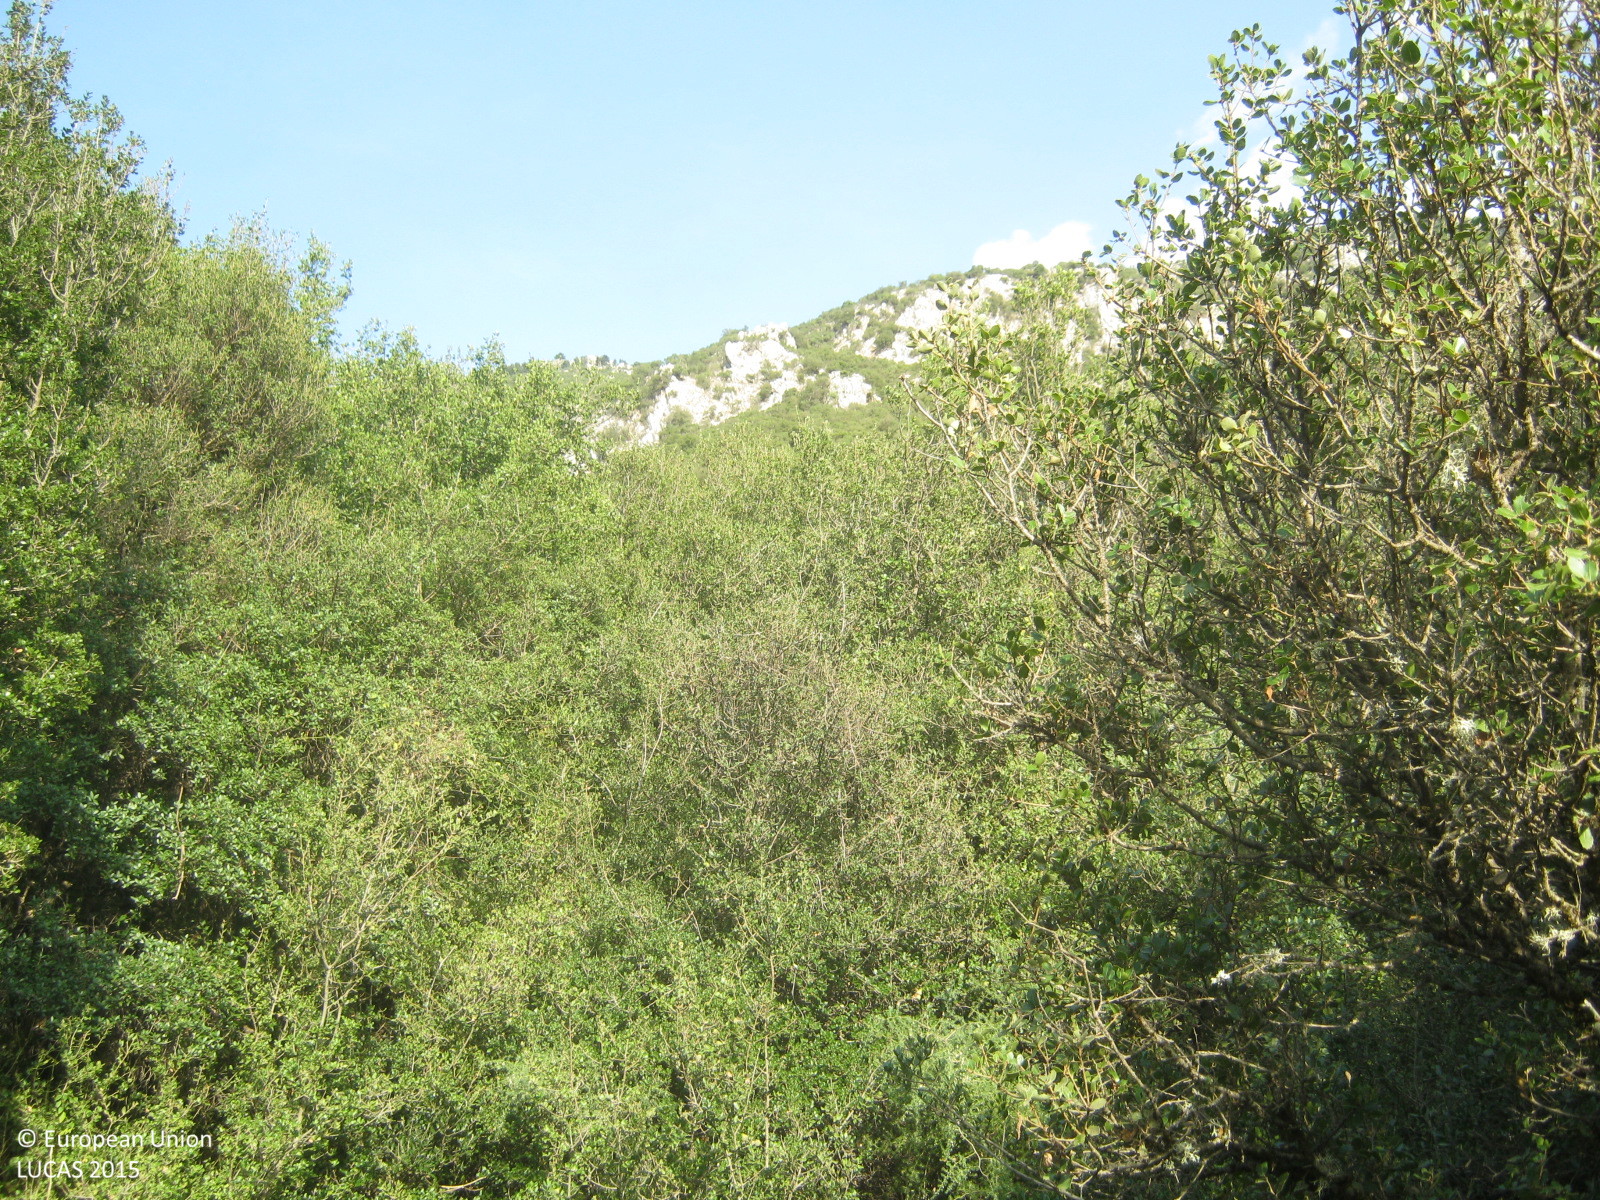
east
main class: Woodland
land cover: Broadleaved woodland
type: broadleaved evergreen forest
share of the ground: > 75 %
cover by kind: broadleaved forest trees 75 %, shrubs 20 %, herbaceous plants 5 %
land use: Semi-natural and natural areas not in use
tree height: < 5 m
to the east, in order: Broadleaved woodland; Grassland without tree/shrub cover; Broadleaved woodland
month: September
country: GR
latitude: 37.9179
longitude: 22.1488
